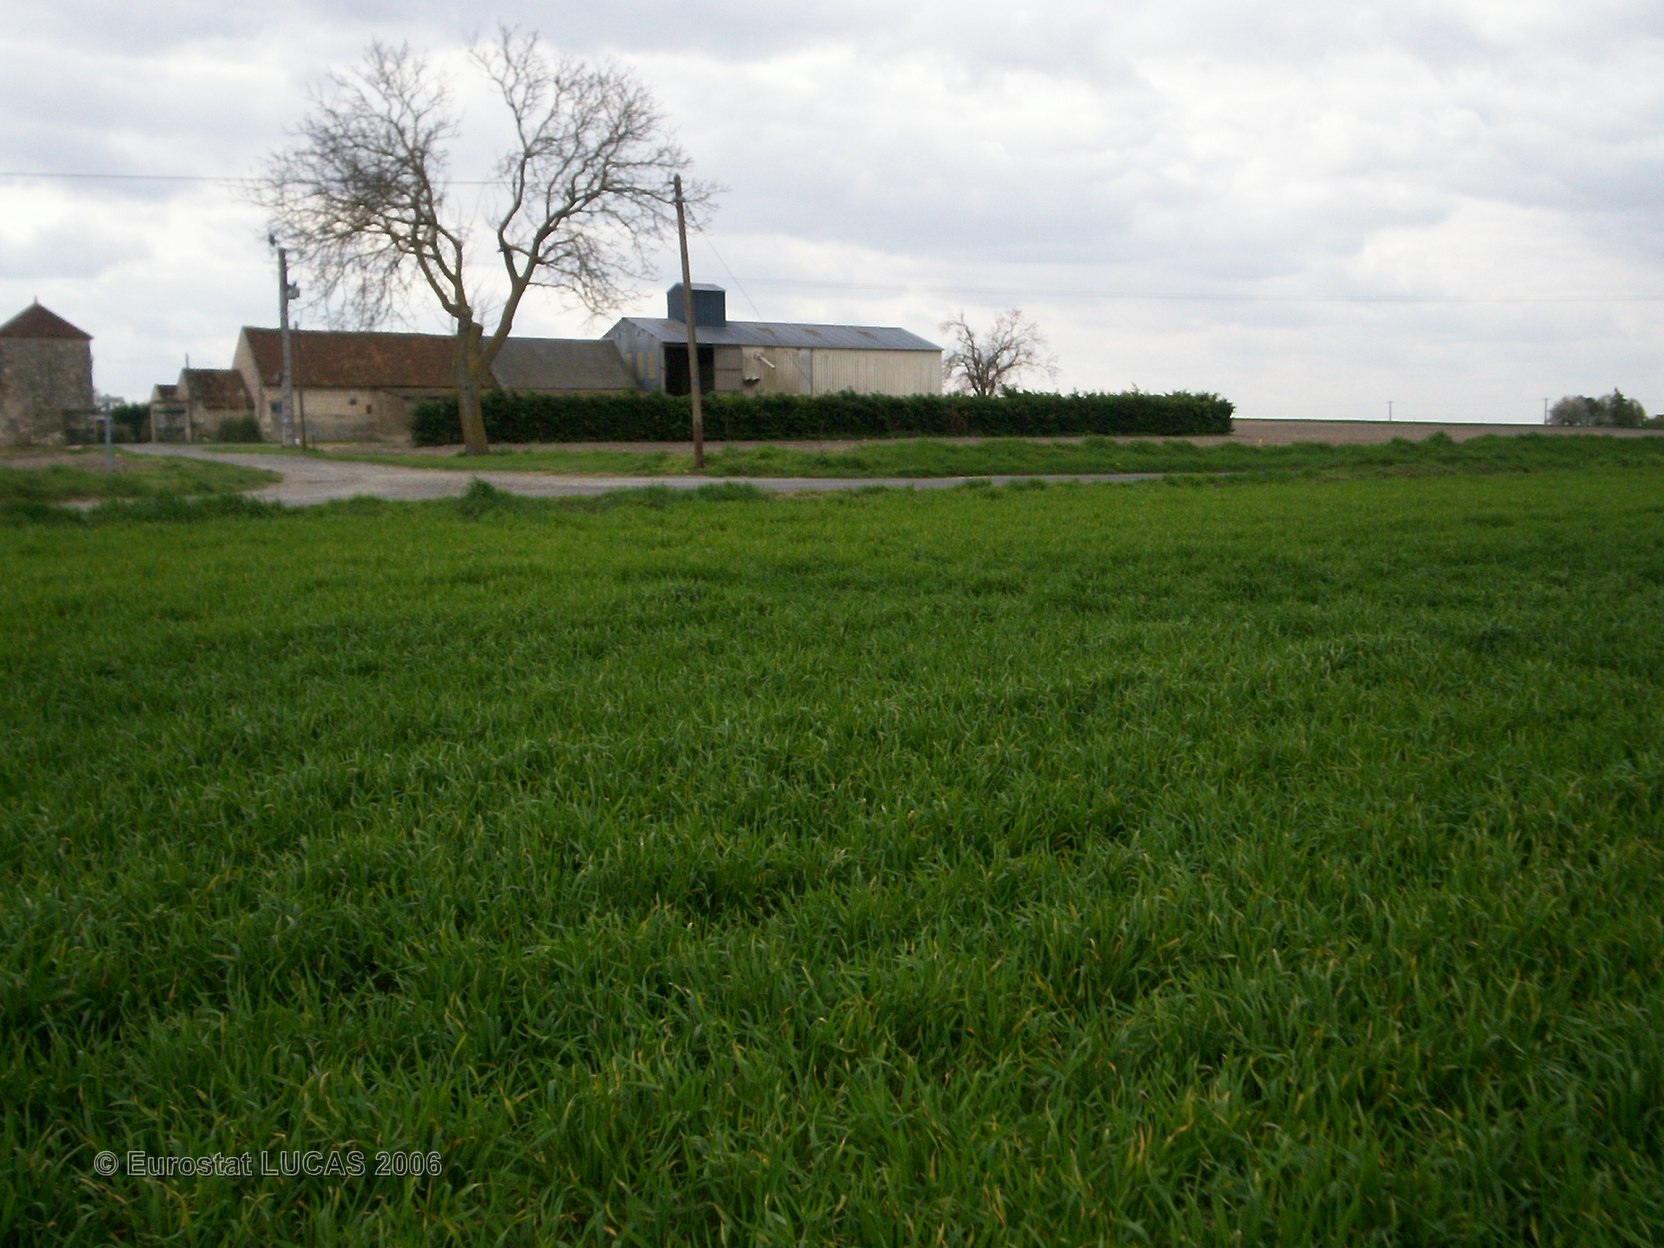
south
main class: Cropland
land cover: Common wheat
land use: Agriculture (excluding fallow land and kitchen gardens)
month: April
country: FR
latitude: 47.0418
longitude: 0.5971
